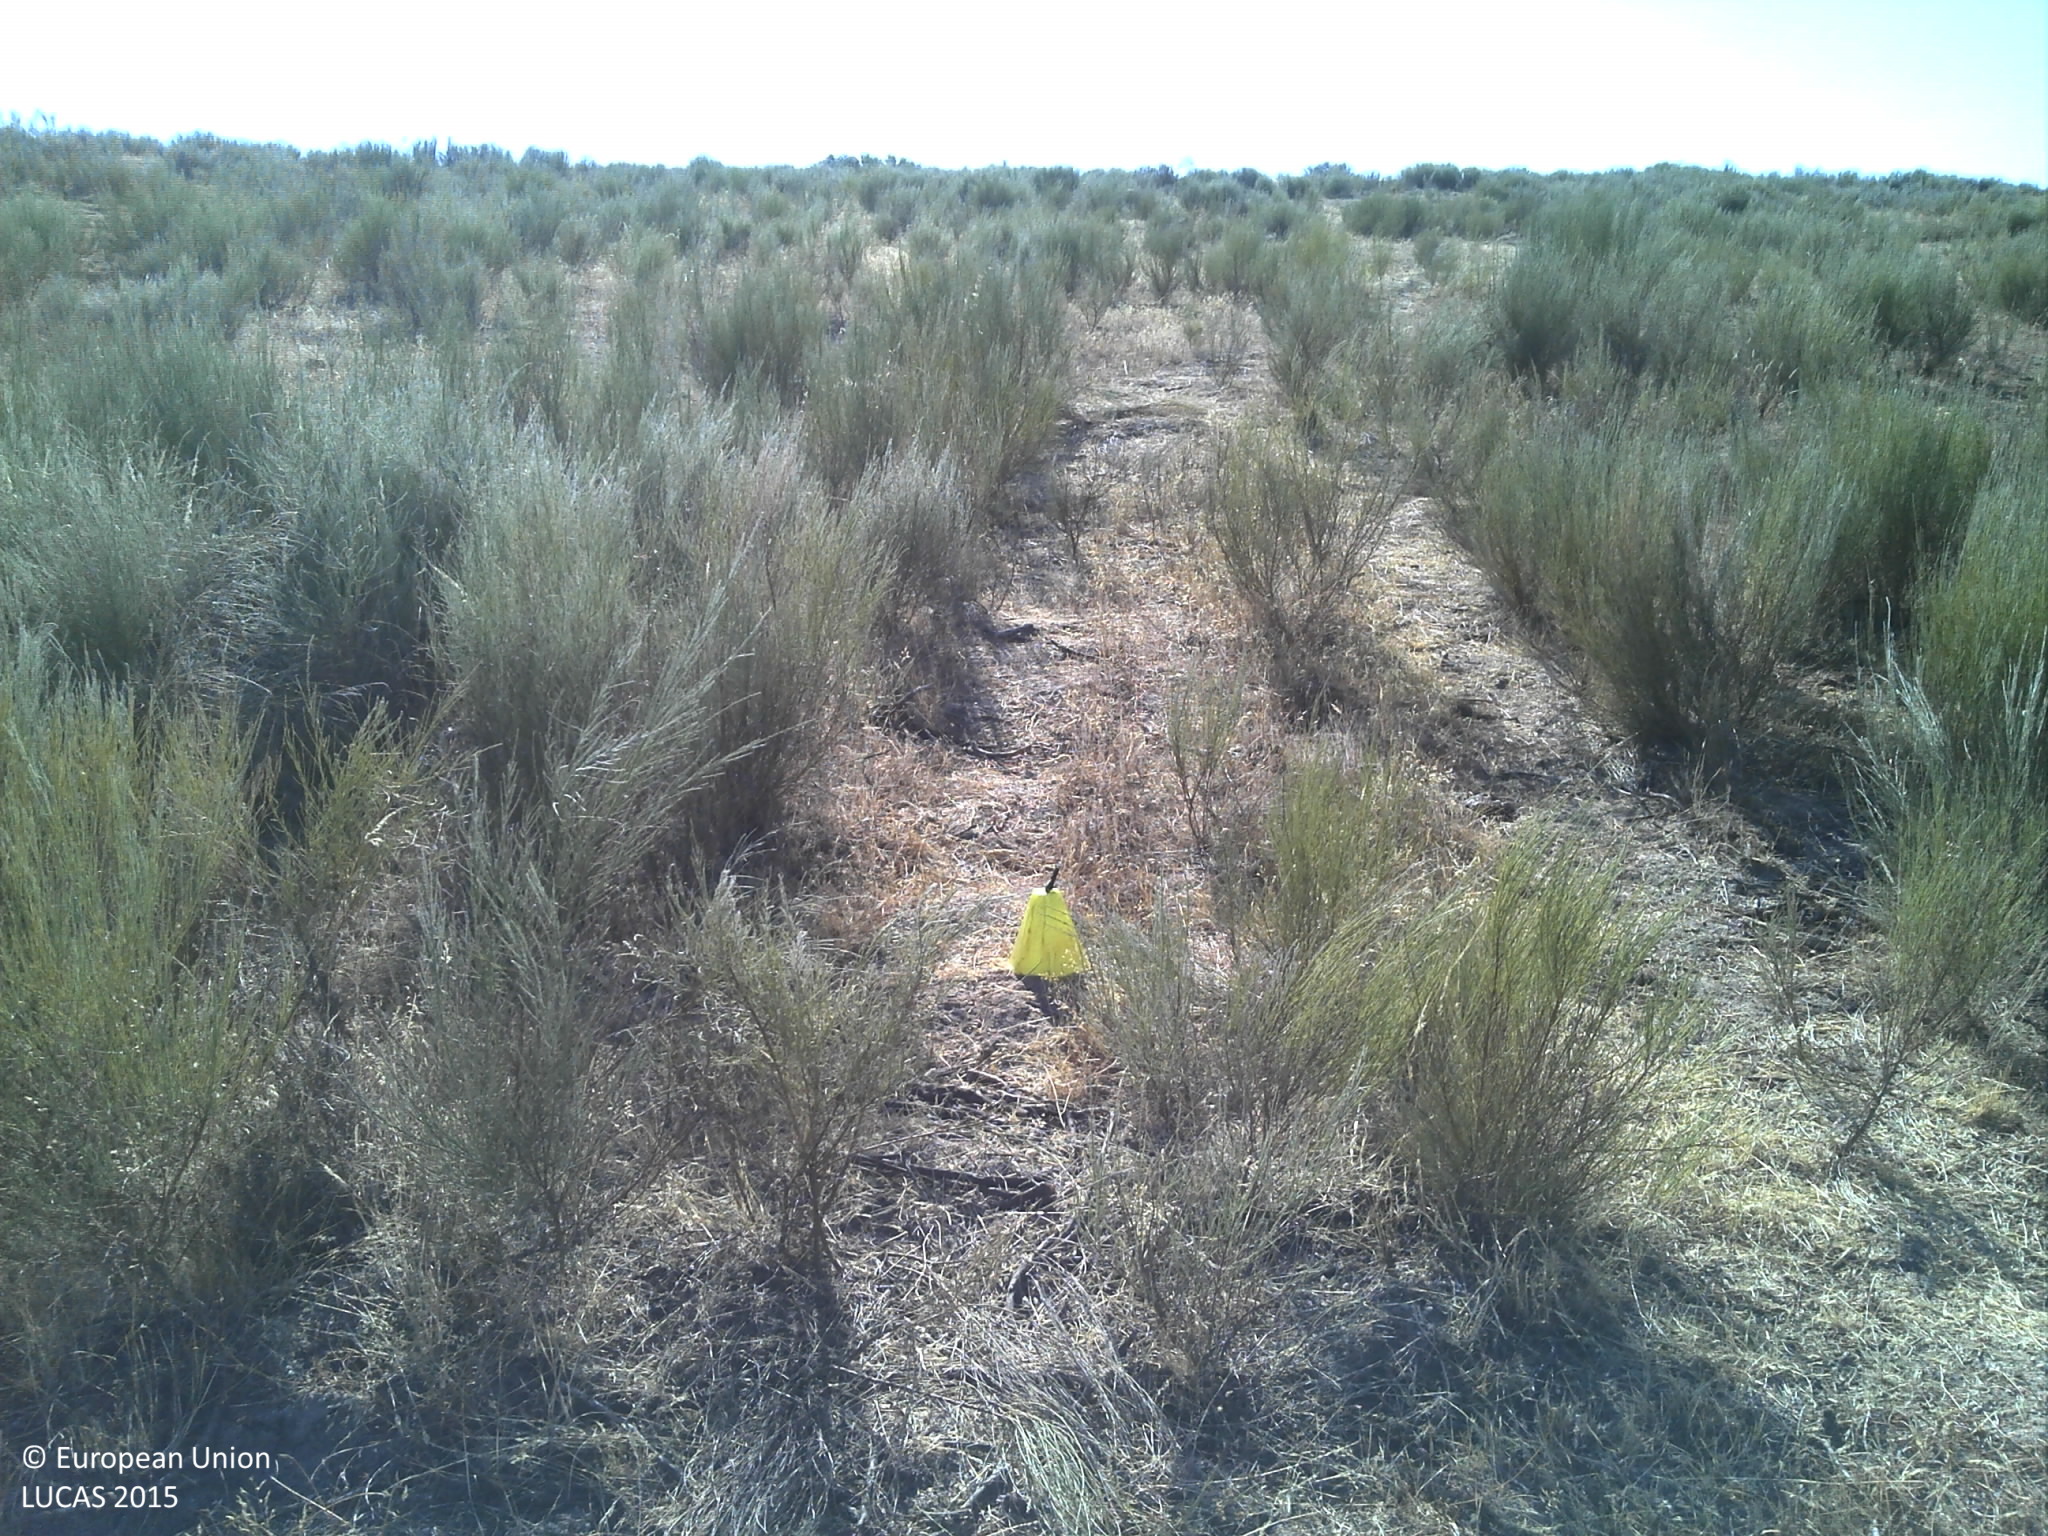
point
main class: Shrubland
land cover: Shrubland without tree cover
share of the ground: 25 - 50 %
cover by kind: unconsolidated bare surface 50 %, shrubs 30 %, herbaceous plants 20 %
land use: Agriculture (excluding fallow land and kitchen gardens)
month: August
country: PT
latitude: 39.4360
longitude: -7.5082
